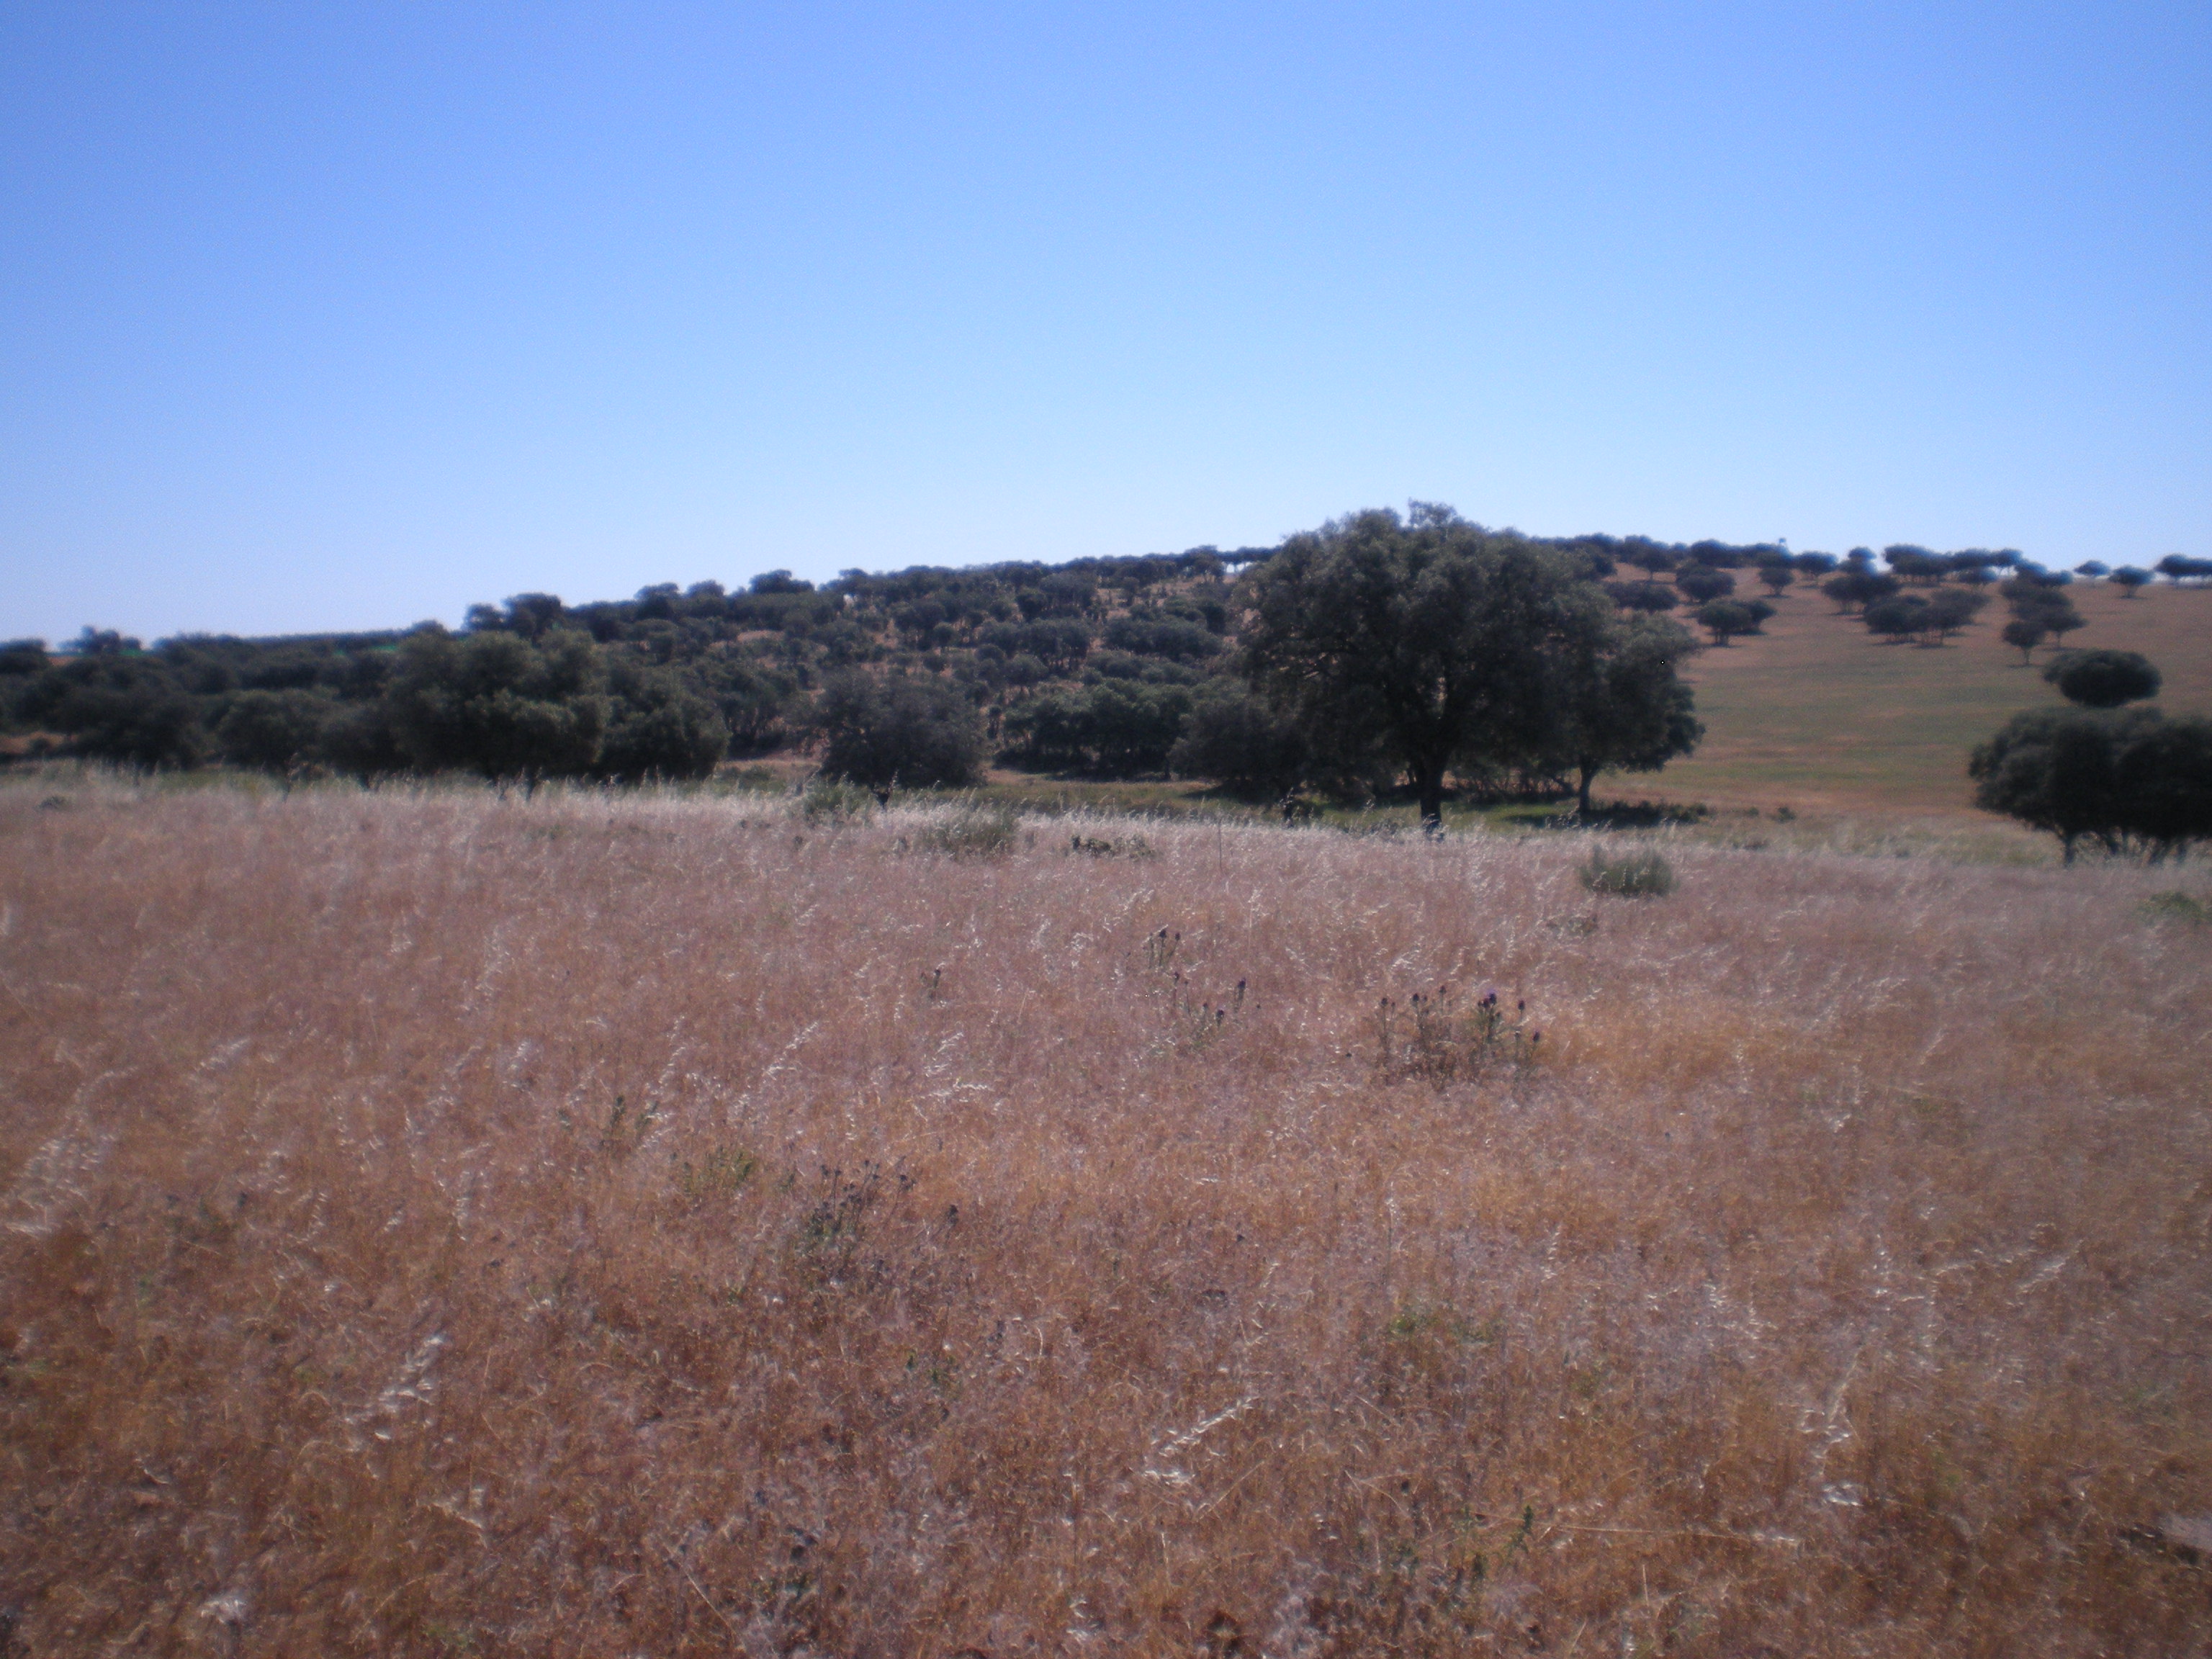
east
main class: Grassland
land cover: Spontaneously vegetated surfaces
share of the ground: 10 - 25 %
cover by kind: unconsolidated bare surface 90 %, herbaceous plants 10 %
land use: Fallow land
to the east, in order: Spontaneously vegetated surfaces; Single bushes/trees; Spontaneously vegetated surfaces; Single bushes/trees; Spontaneously vegetated surfaces; Broadleaved woodland; Rivers and streams; Tracks; Spontaneously vegetated surfaces; Tracks; Broadleaved woodland
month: May
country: ES
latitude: 38.4602
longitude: -3.4269
